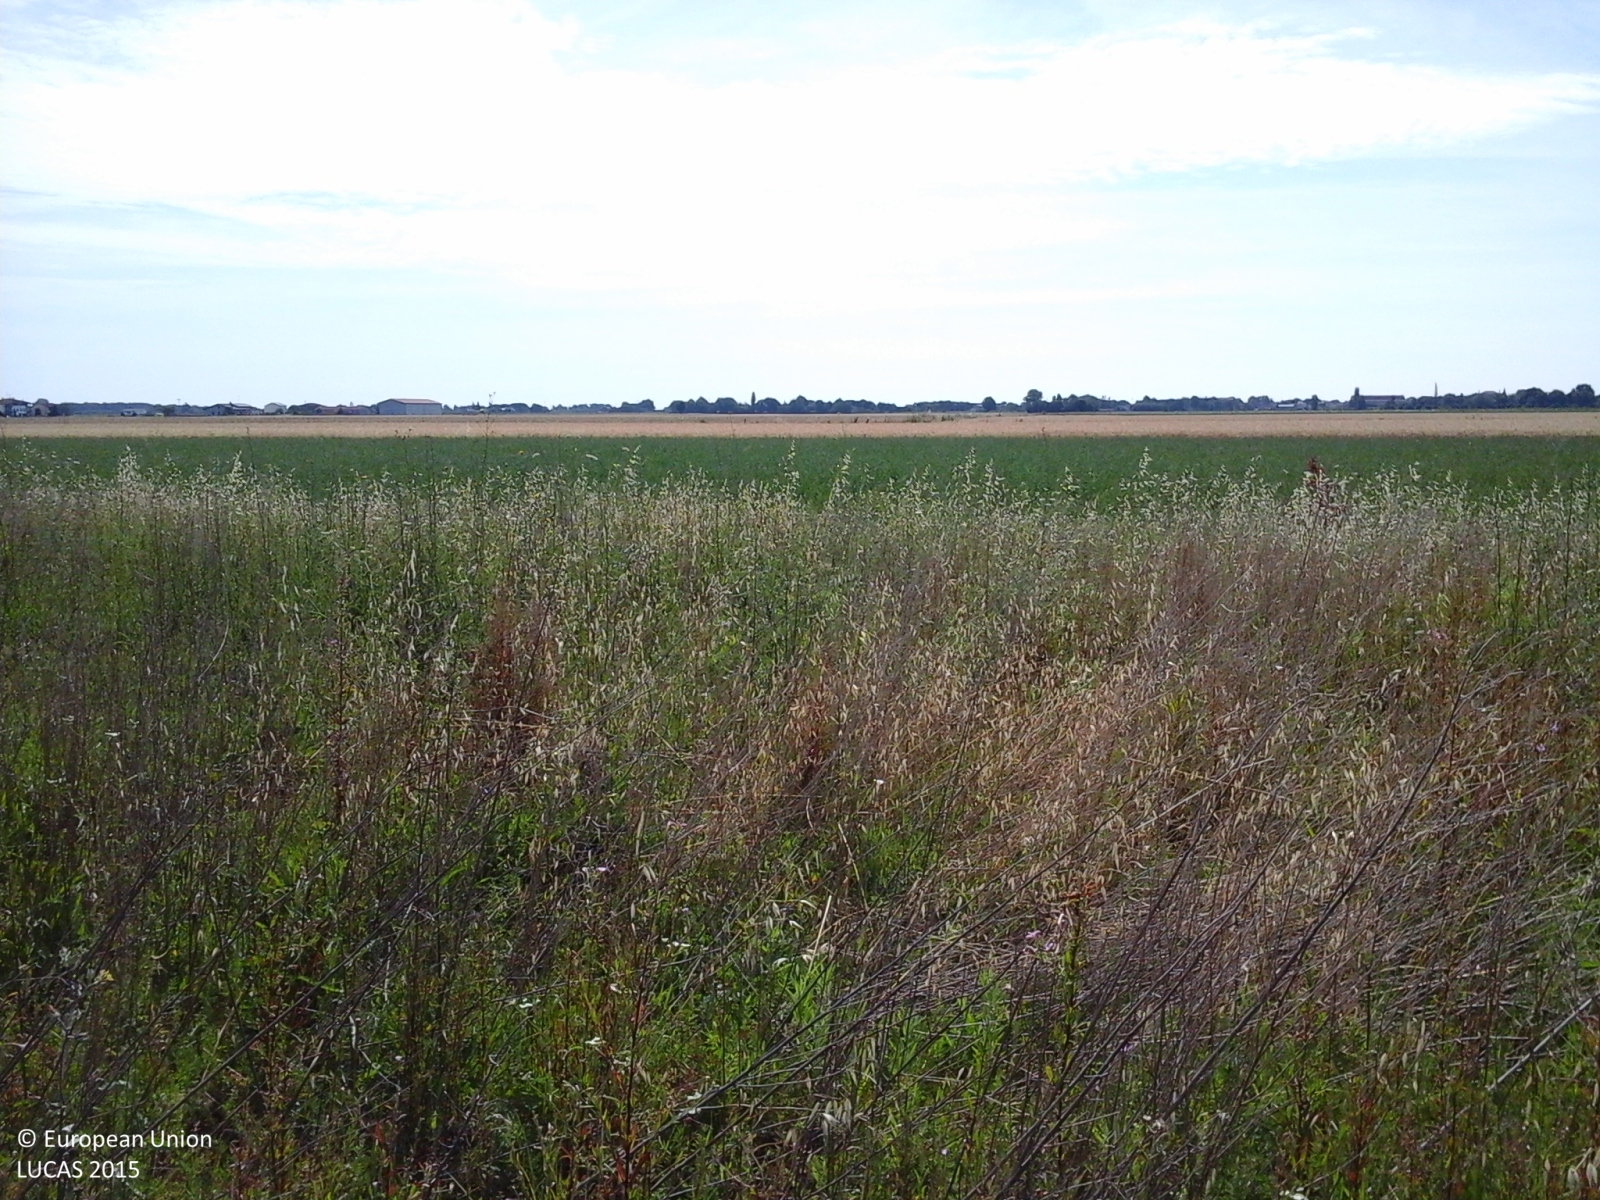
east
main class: Grassland
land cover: Spontaneously vegetated surfaces
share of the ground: > 75 %
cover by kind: herbaceous plants 100 %
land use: Fallow land
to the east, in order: Spontaneously vegetated surfaces; Ditches and canals; Lucerne; Ditches and canals; Common wheat; Ditches and canals; Tracks; Ditches and canals; Durum wheat; Ditches and canals; Durum wheat; Ditches and canals; Durum wheat; Ditches and canals; Durum wheat; Ditches and canals
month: June
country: IT
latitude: 44.2723
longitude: 12.2376
